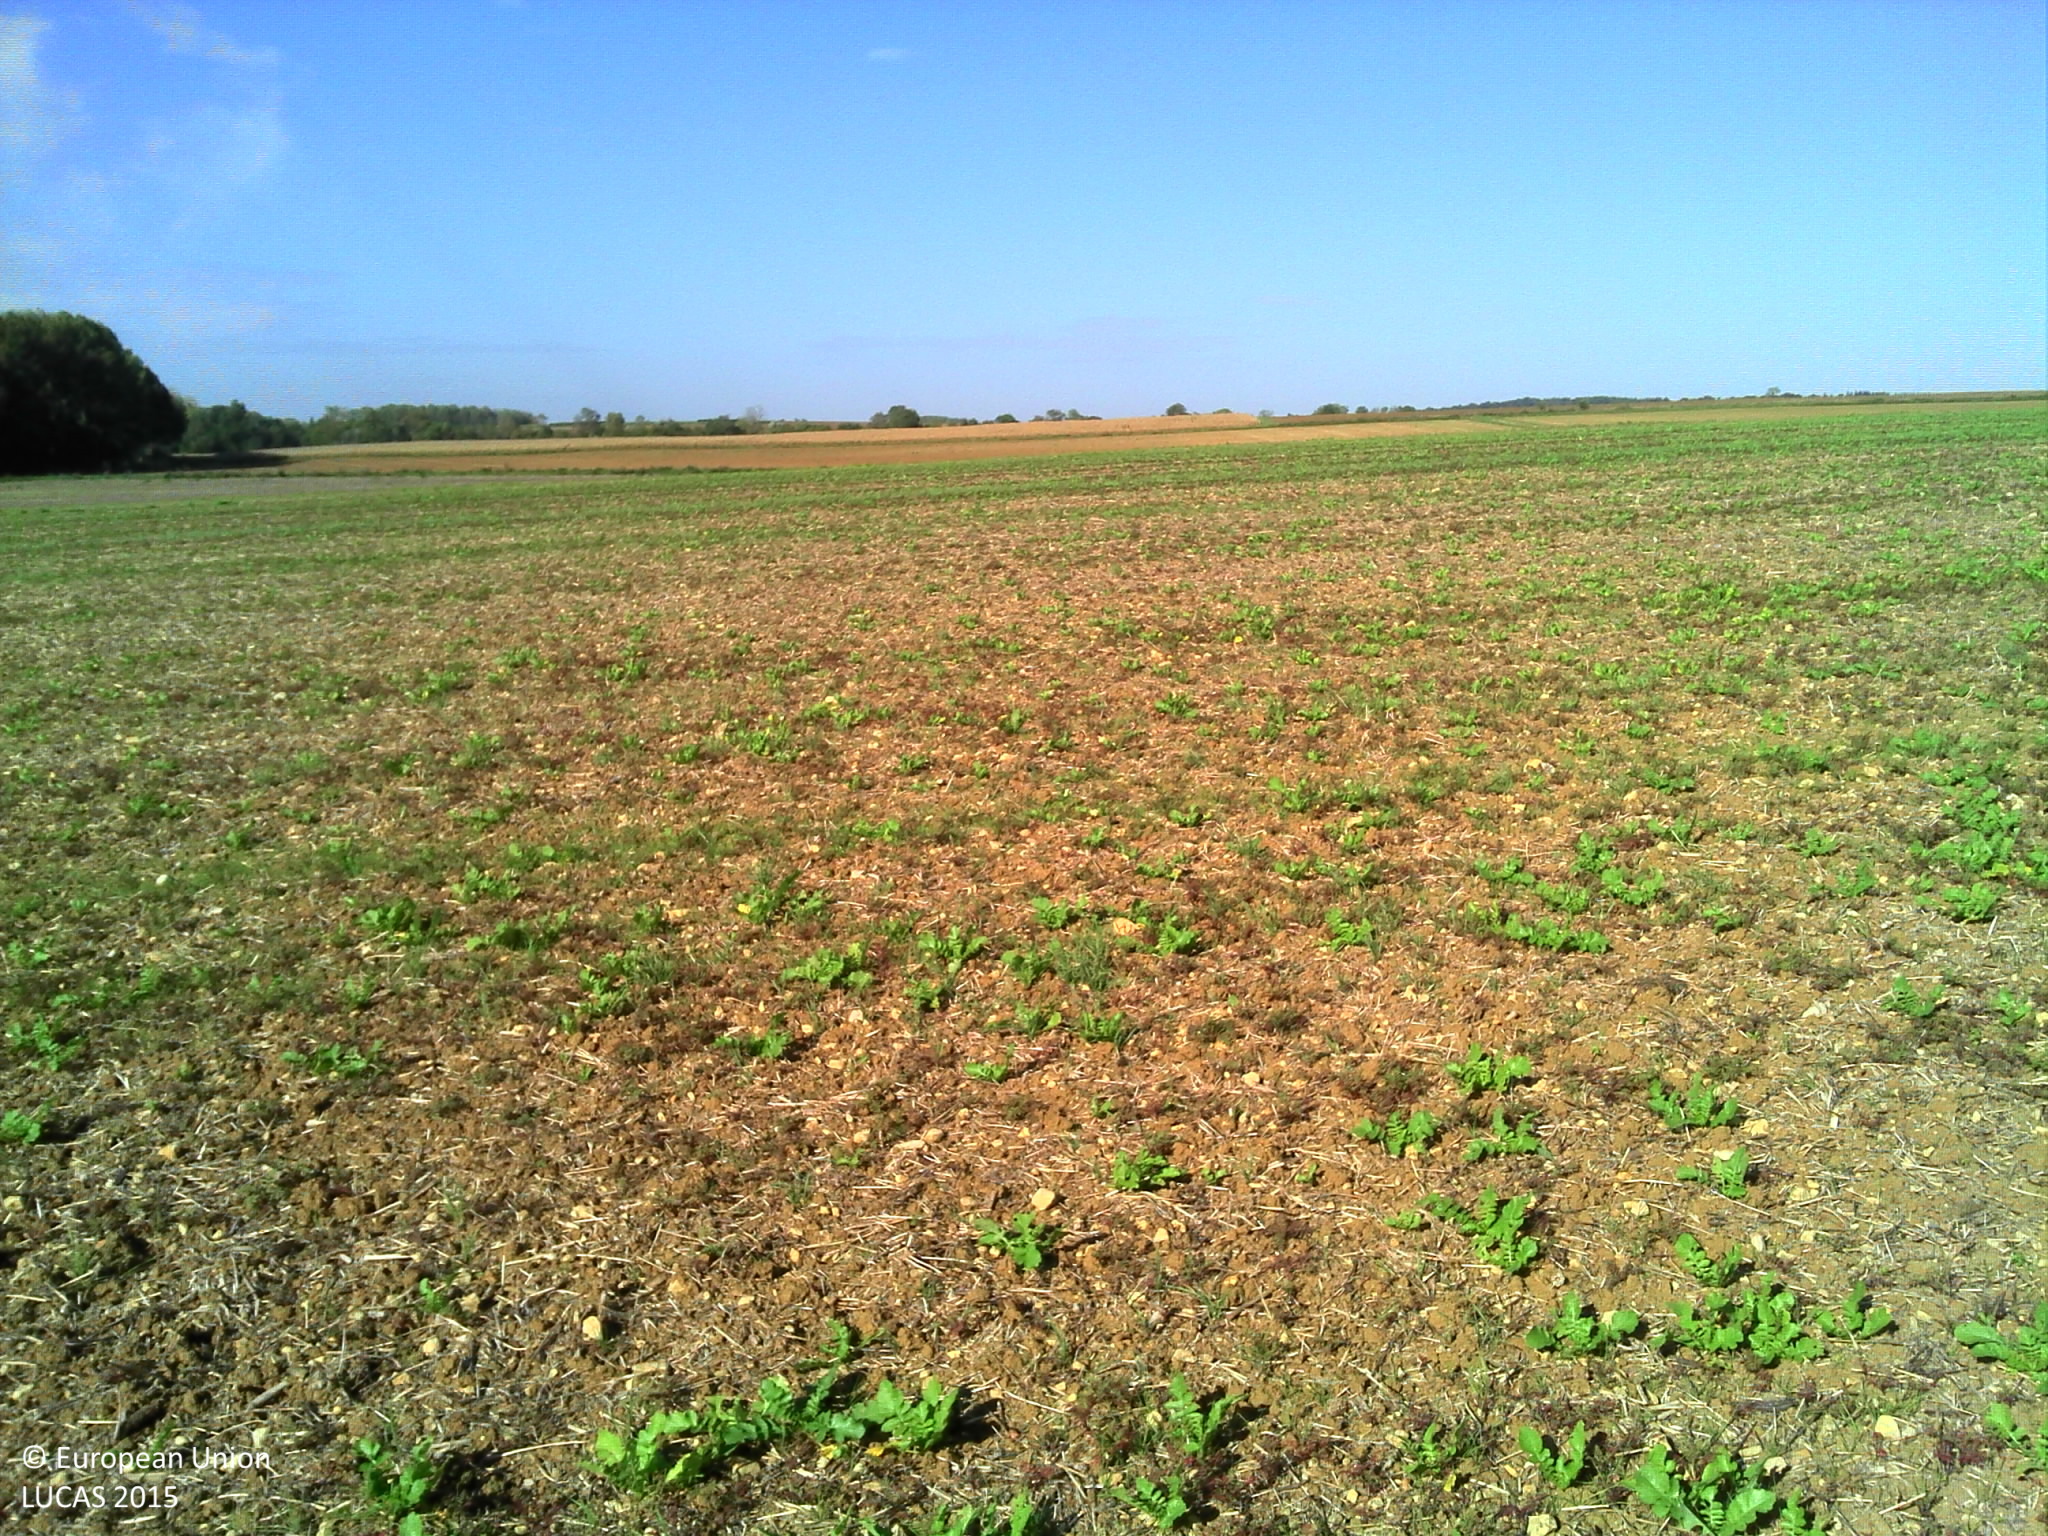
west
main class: Cropland
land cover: Other leguminous and mixtures for fodder
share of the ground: 10 - 25 %
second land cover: Other root crops
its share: 10 - 25 %
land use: Agriculture (excluding fallow land and kitchen gardens)
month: September
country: FR
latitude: 46.5603
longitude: -1.0292
